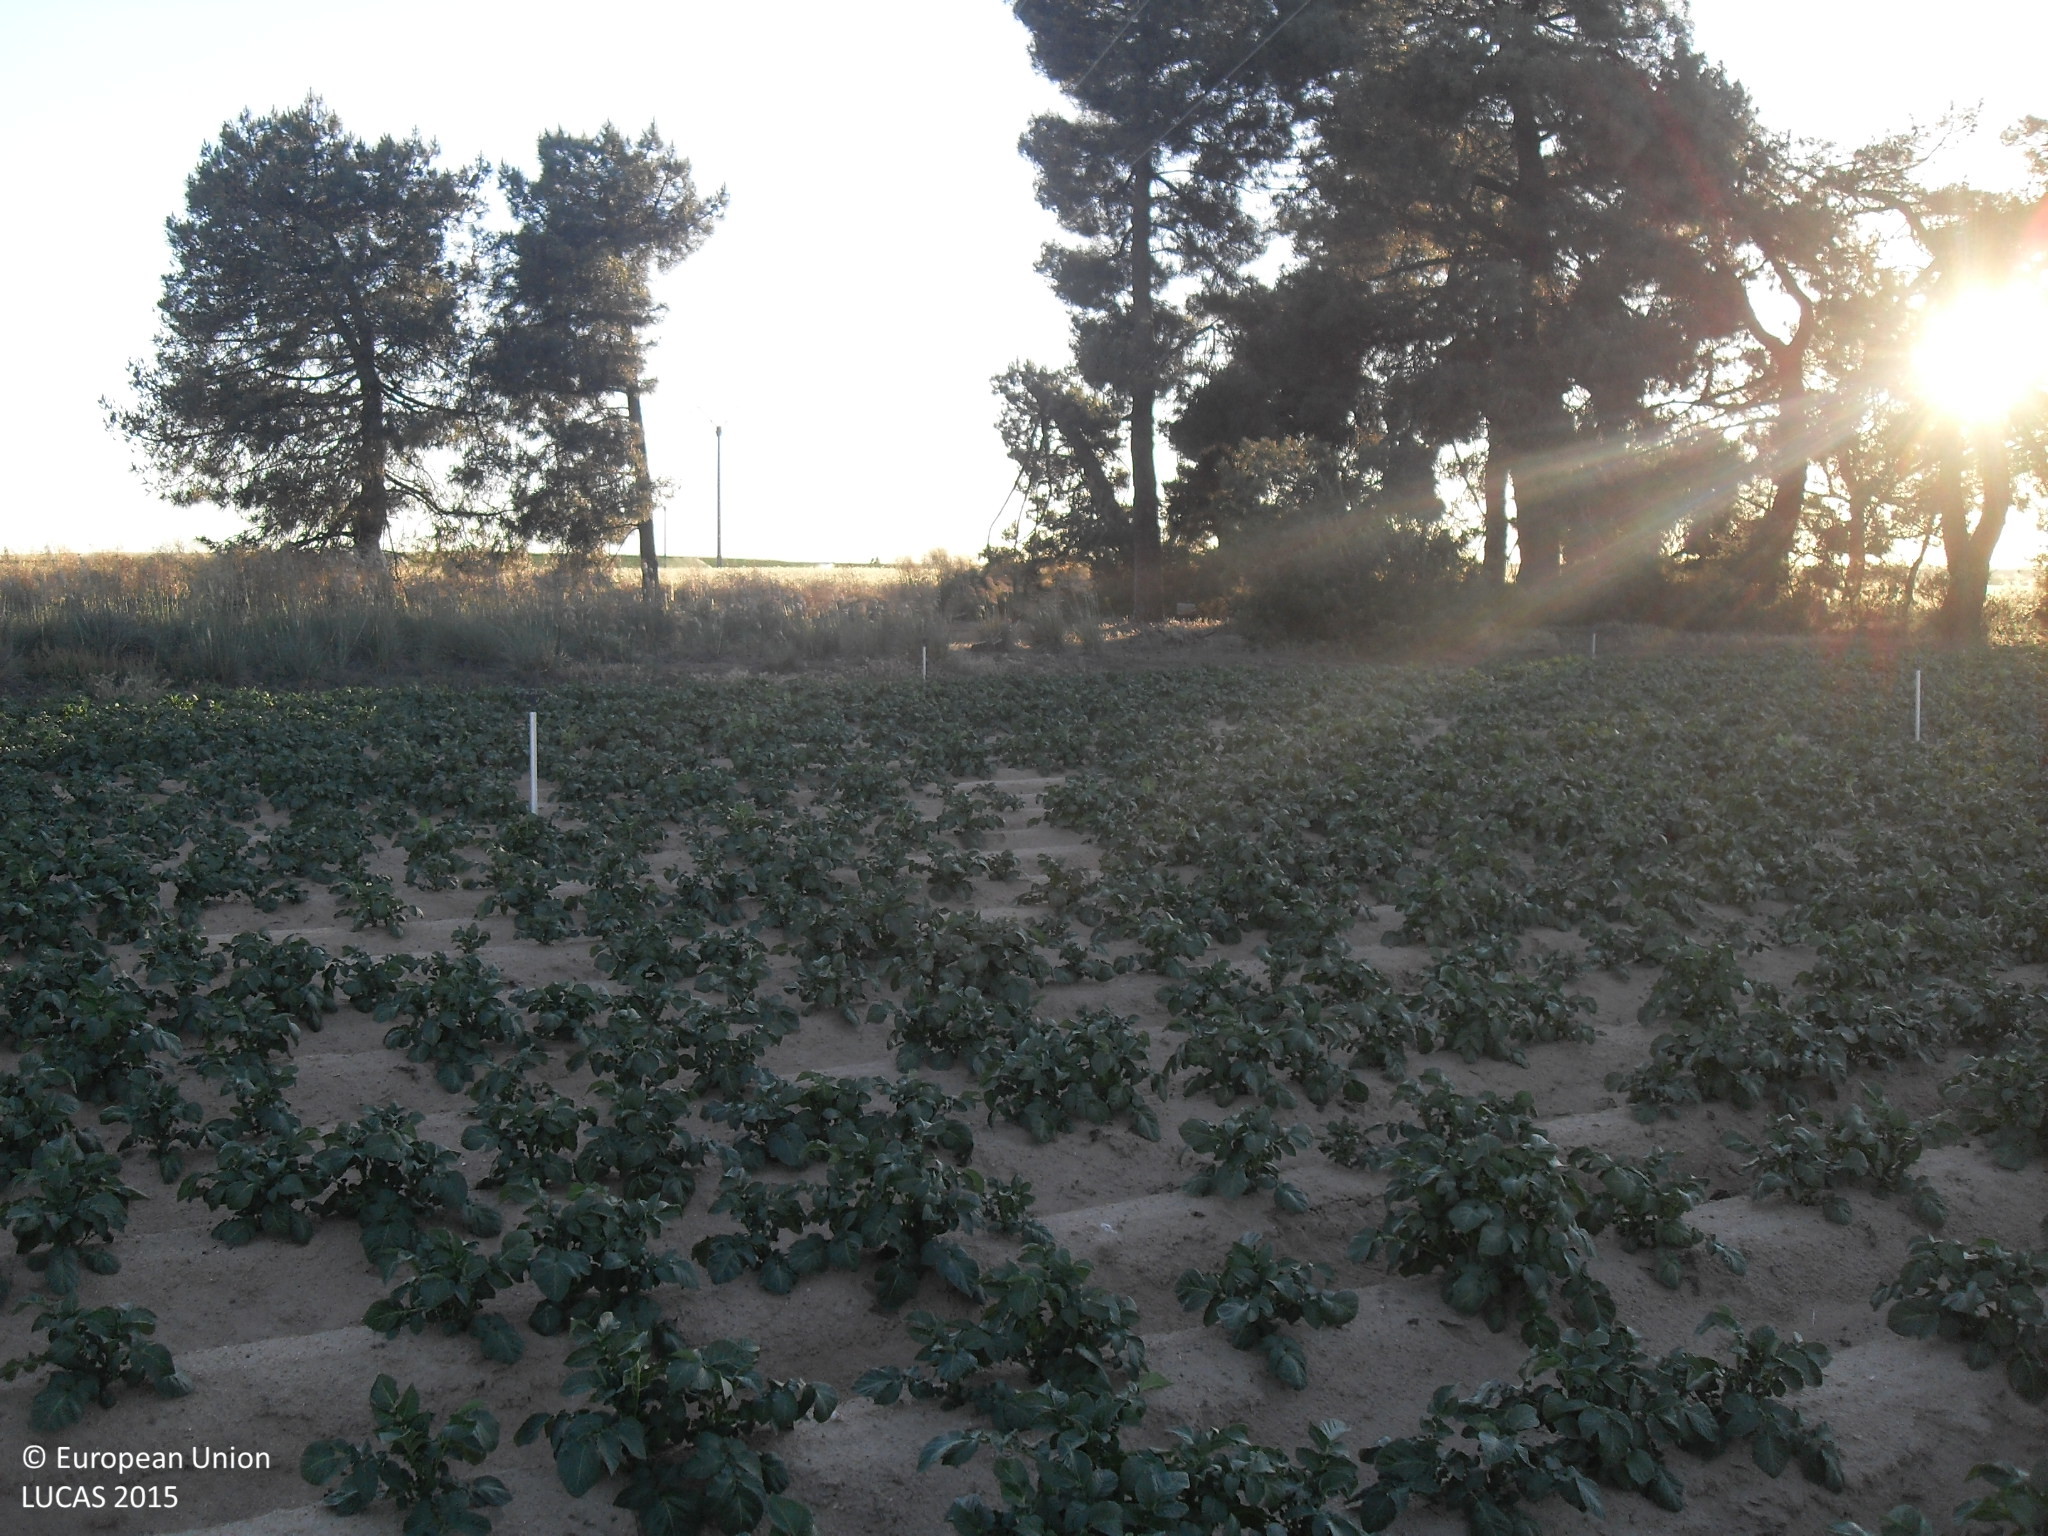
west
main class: Cropland
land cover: Potatoes
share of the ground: 25 - 50 %
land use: Agriculture (excluding fallow land and kitchen gardens)
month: May
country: ES
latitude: 41.0519
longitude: -5.3614
